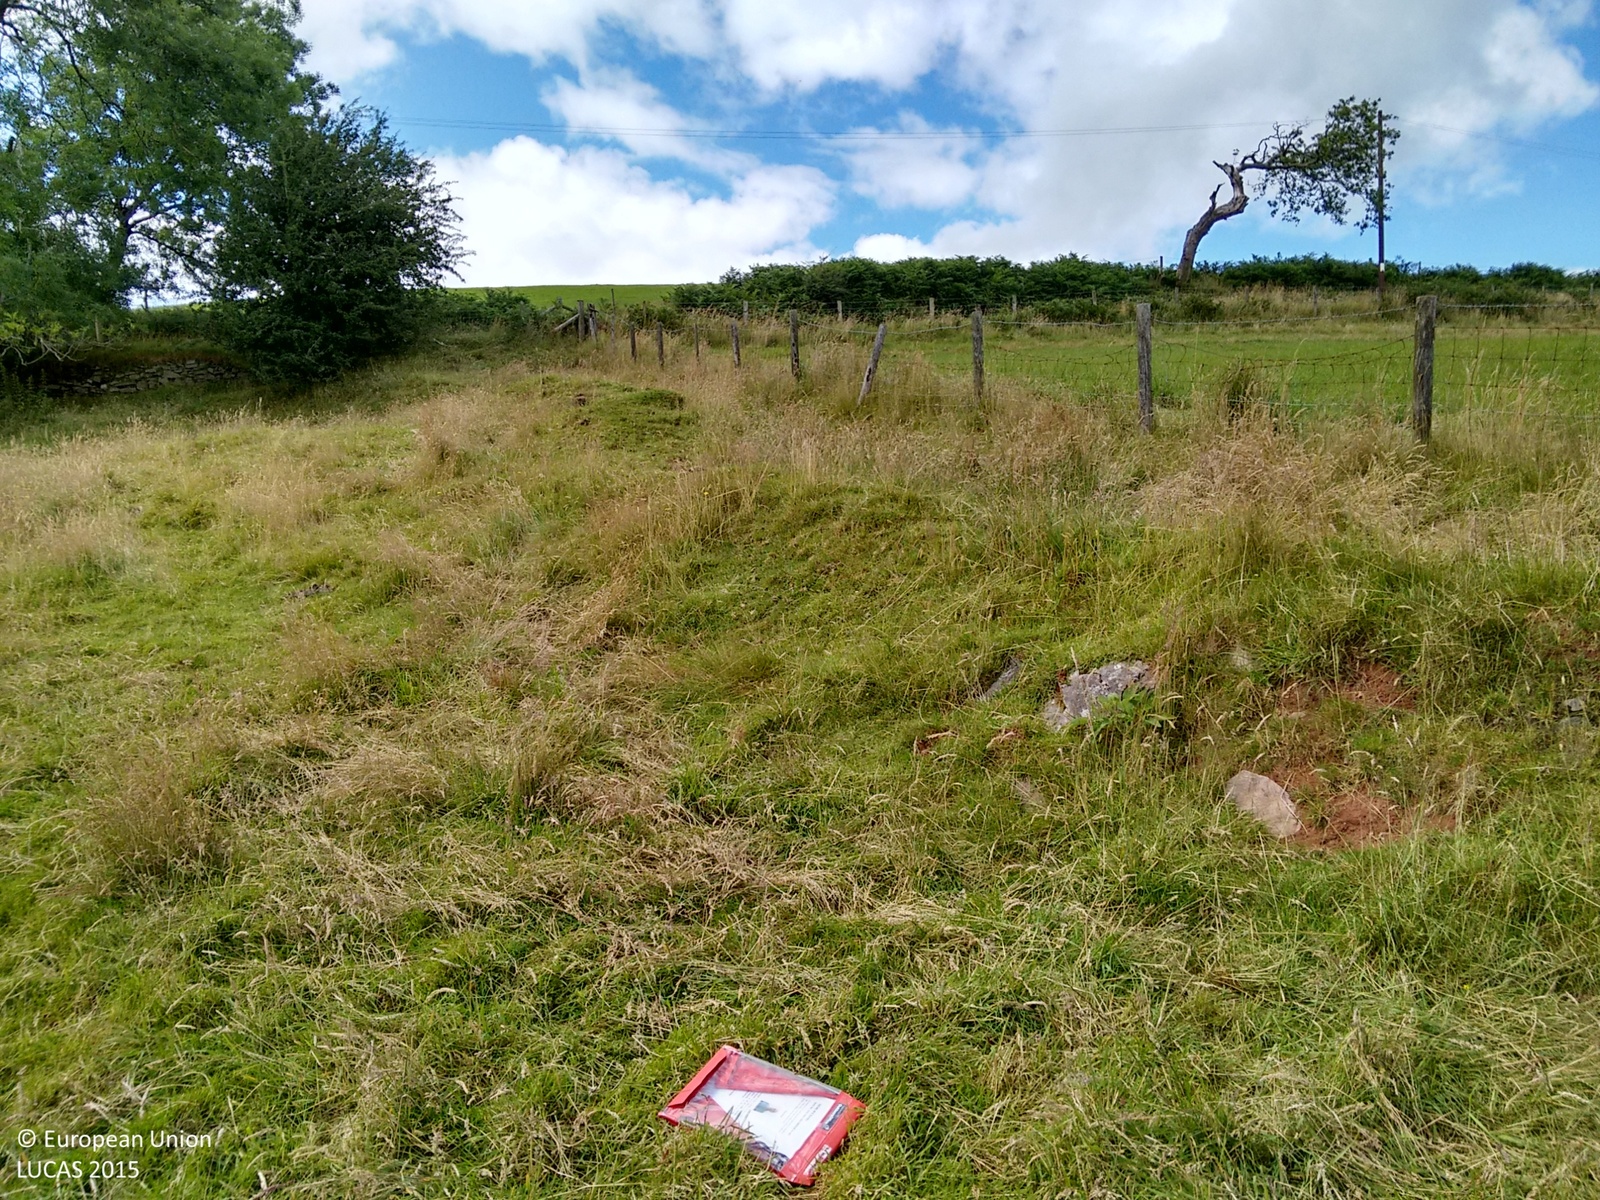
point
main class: Grassland
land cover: Grassland without tree/shrub cover
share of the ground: > 75 %
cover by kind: herbaceous plants 100 %
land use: Agriculture (excluding fallow land and kitchen gardens)
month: July
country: GB
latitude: 51.8854
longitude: -3.8798
